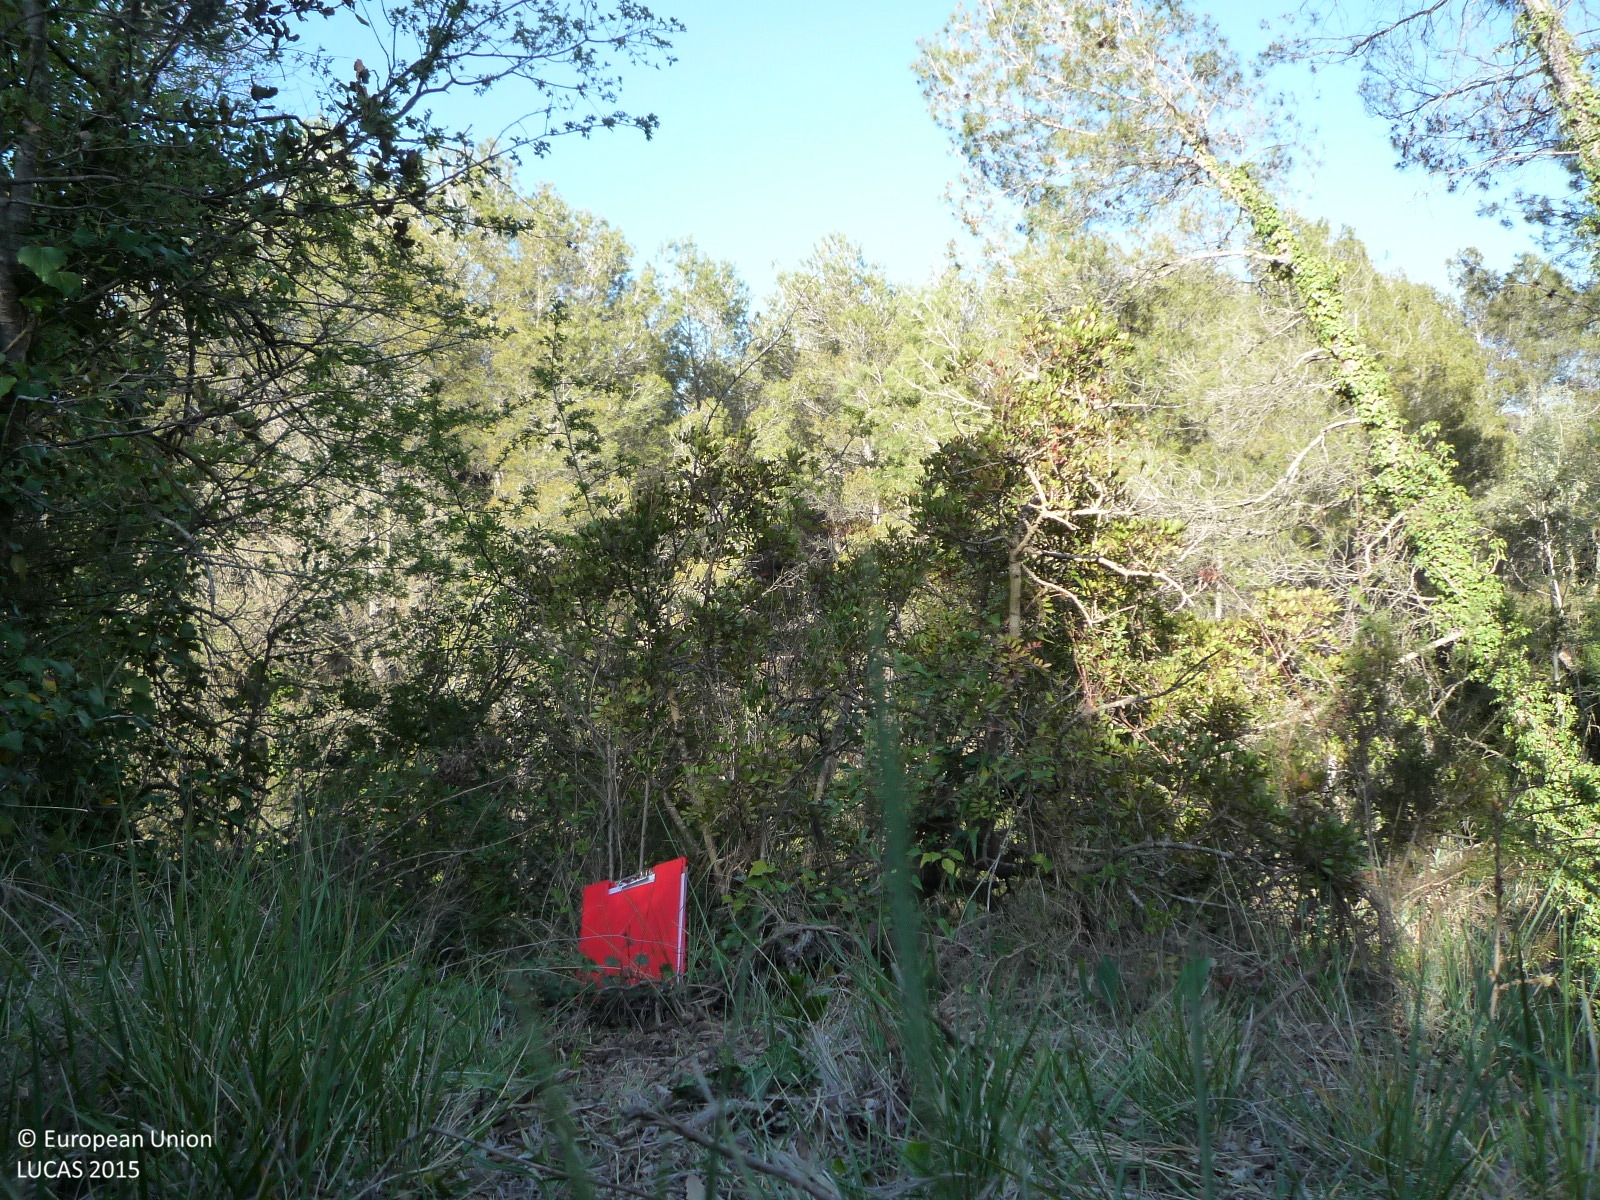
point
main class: Woodland
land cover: Pine dominated mixed woodland
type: coniferous forest of the mediterranean region
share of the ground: > 75 %
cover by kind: coniferous forest trees 55 %, broadleaved forest trees 30 %, shrubs 15 %
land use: Semi-natural and natural areas not in use
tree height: > 5 m
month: April
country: ES
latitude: 41.4195
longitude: 1.6535
